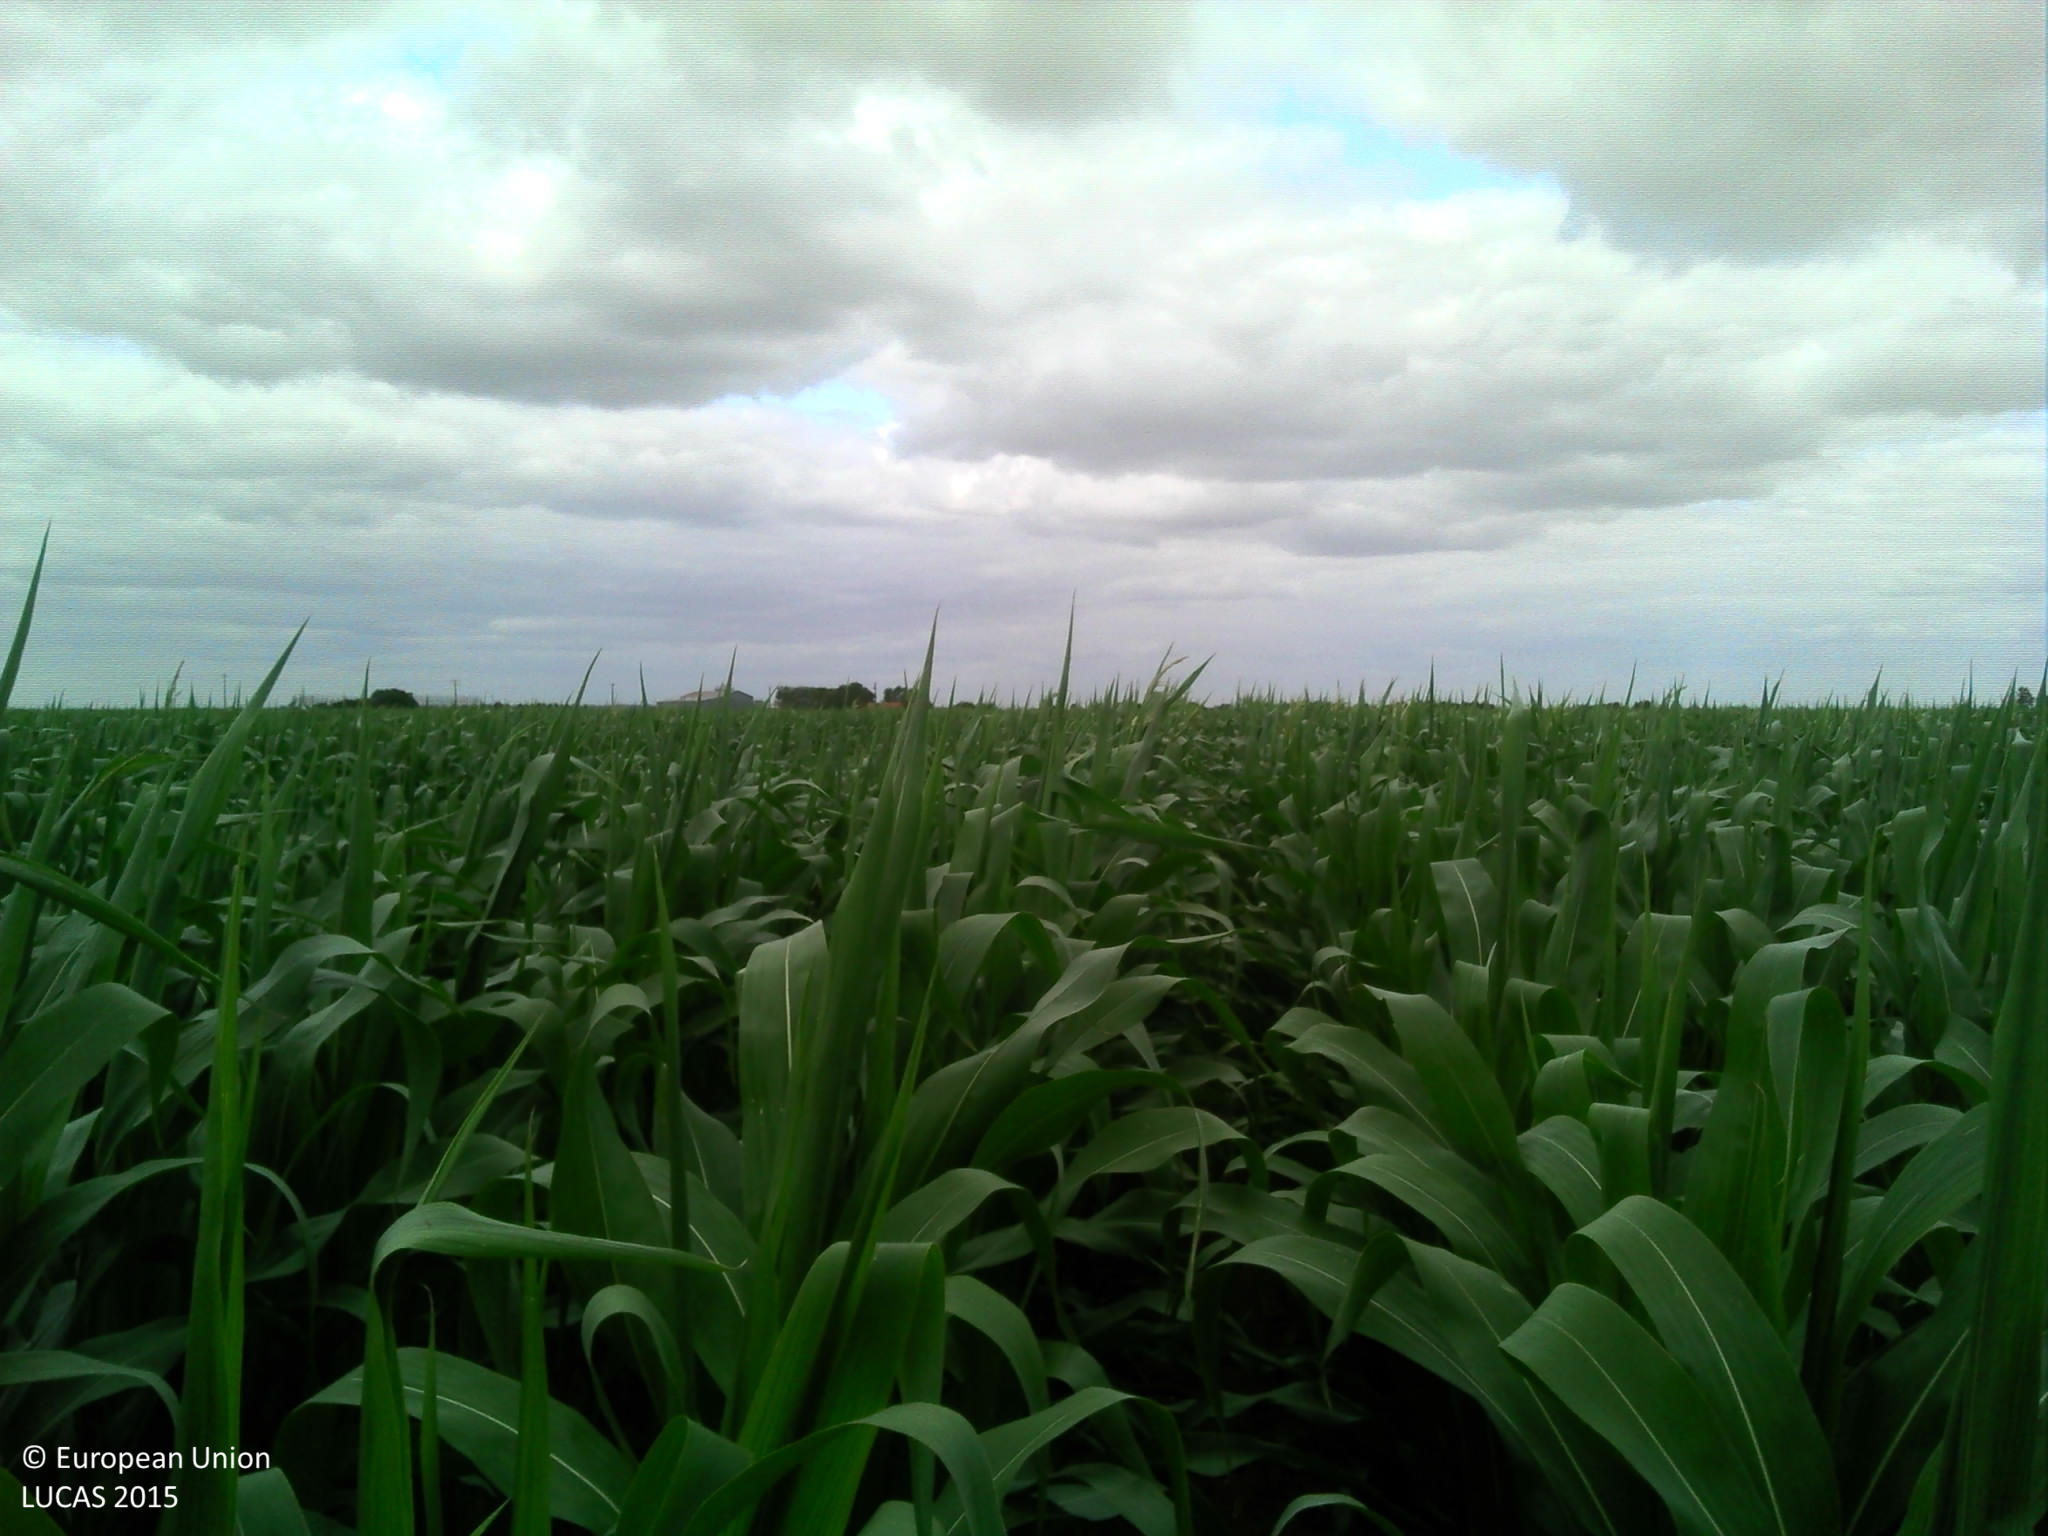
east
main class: Cropland
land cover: Maize
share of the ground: > 75 %
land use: Agriculture (excluding fallow land and kitchen gardens)
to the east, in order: Maize
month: July
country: FR
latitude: 46.3624
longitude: -1.3562
